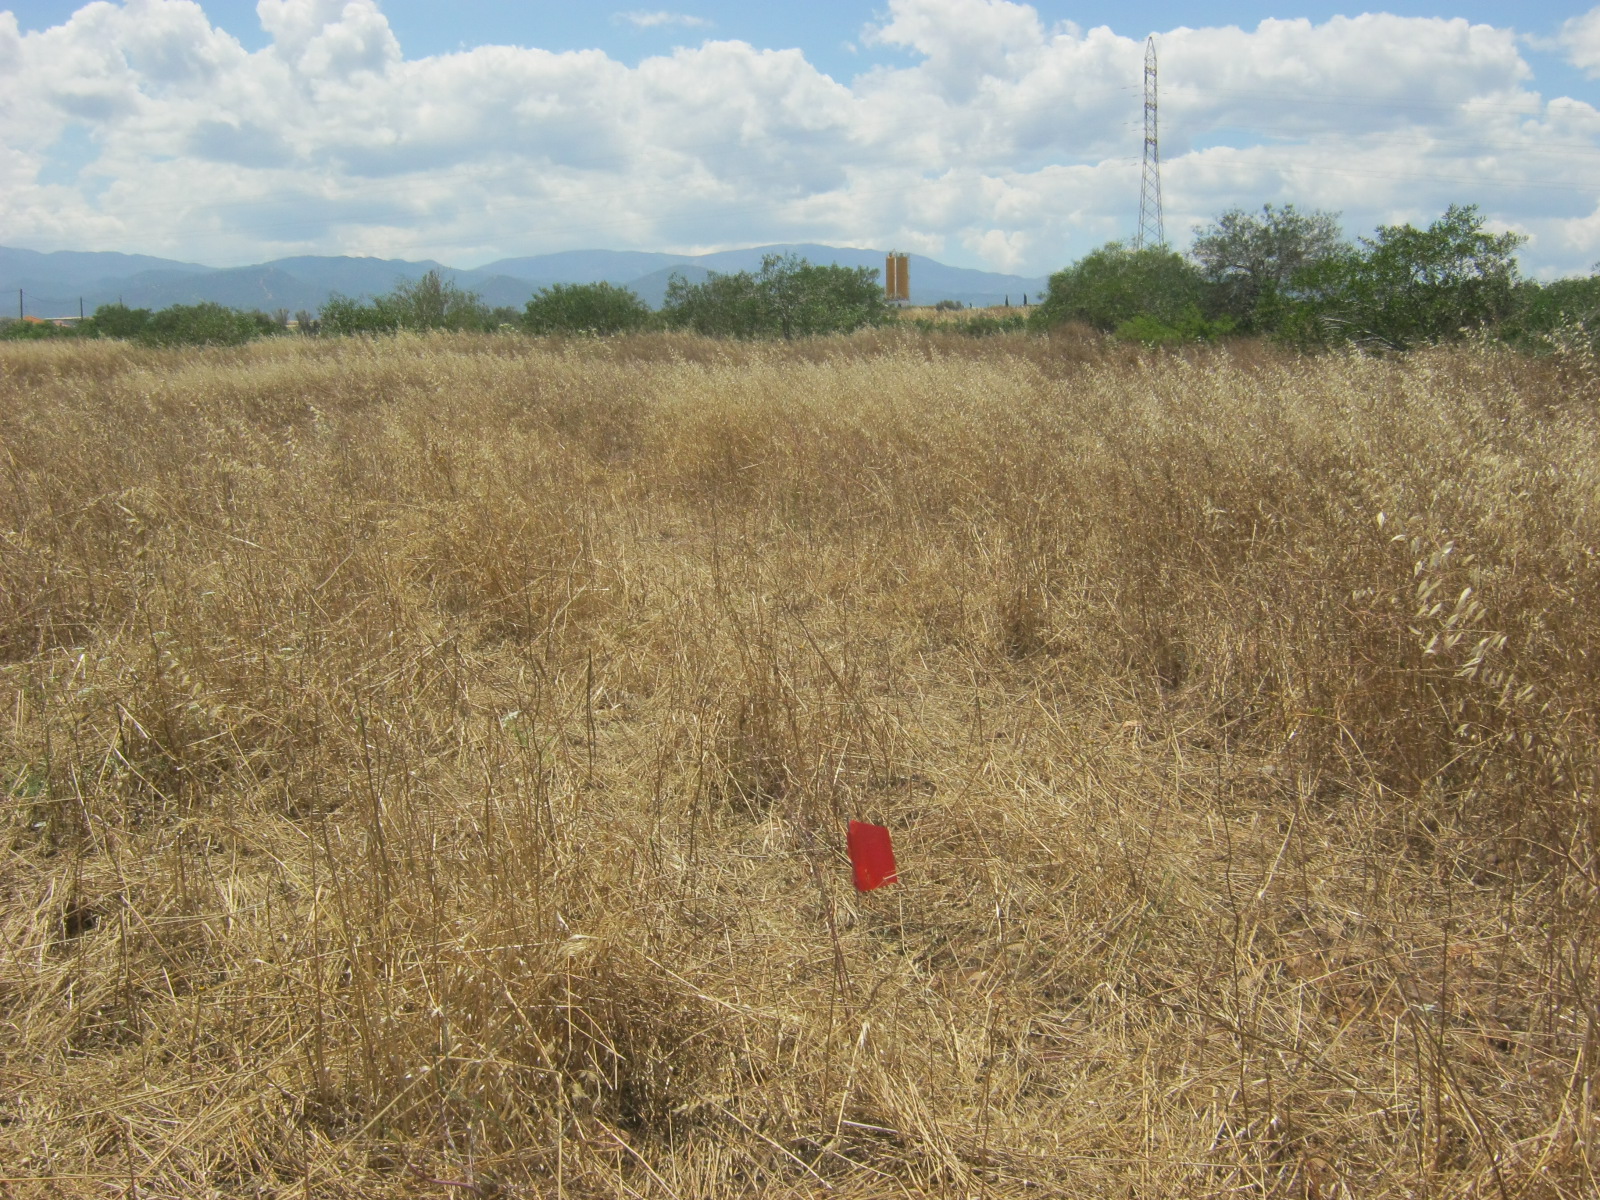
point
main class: Grassland
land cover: Spontaneously vegetated surfaces
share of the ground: > 75 %
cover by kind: herbaceous plants 100 %
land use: Abandoned areas
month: May
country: CY
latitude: 35.1449
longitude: 33.0209
